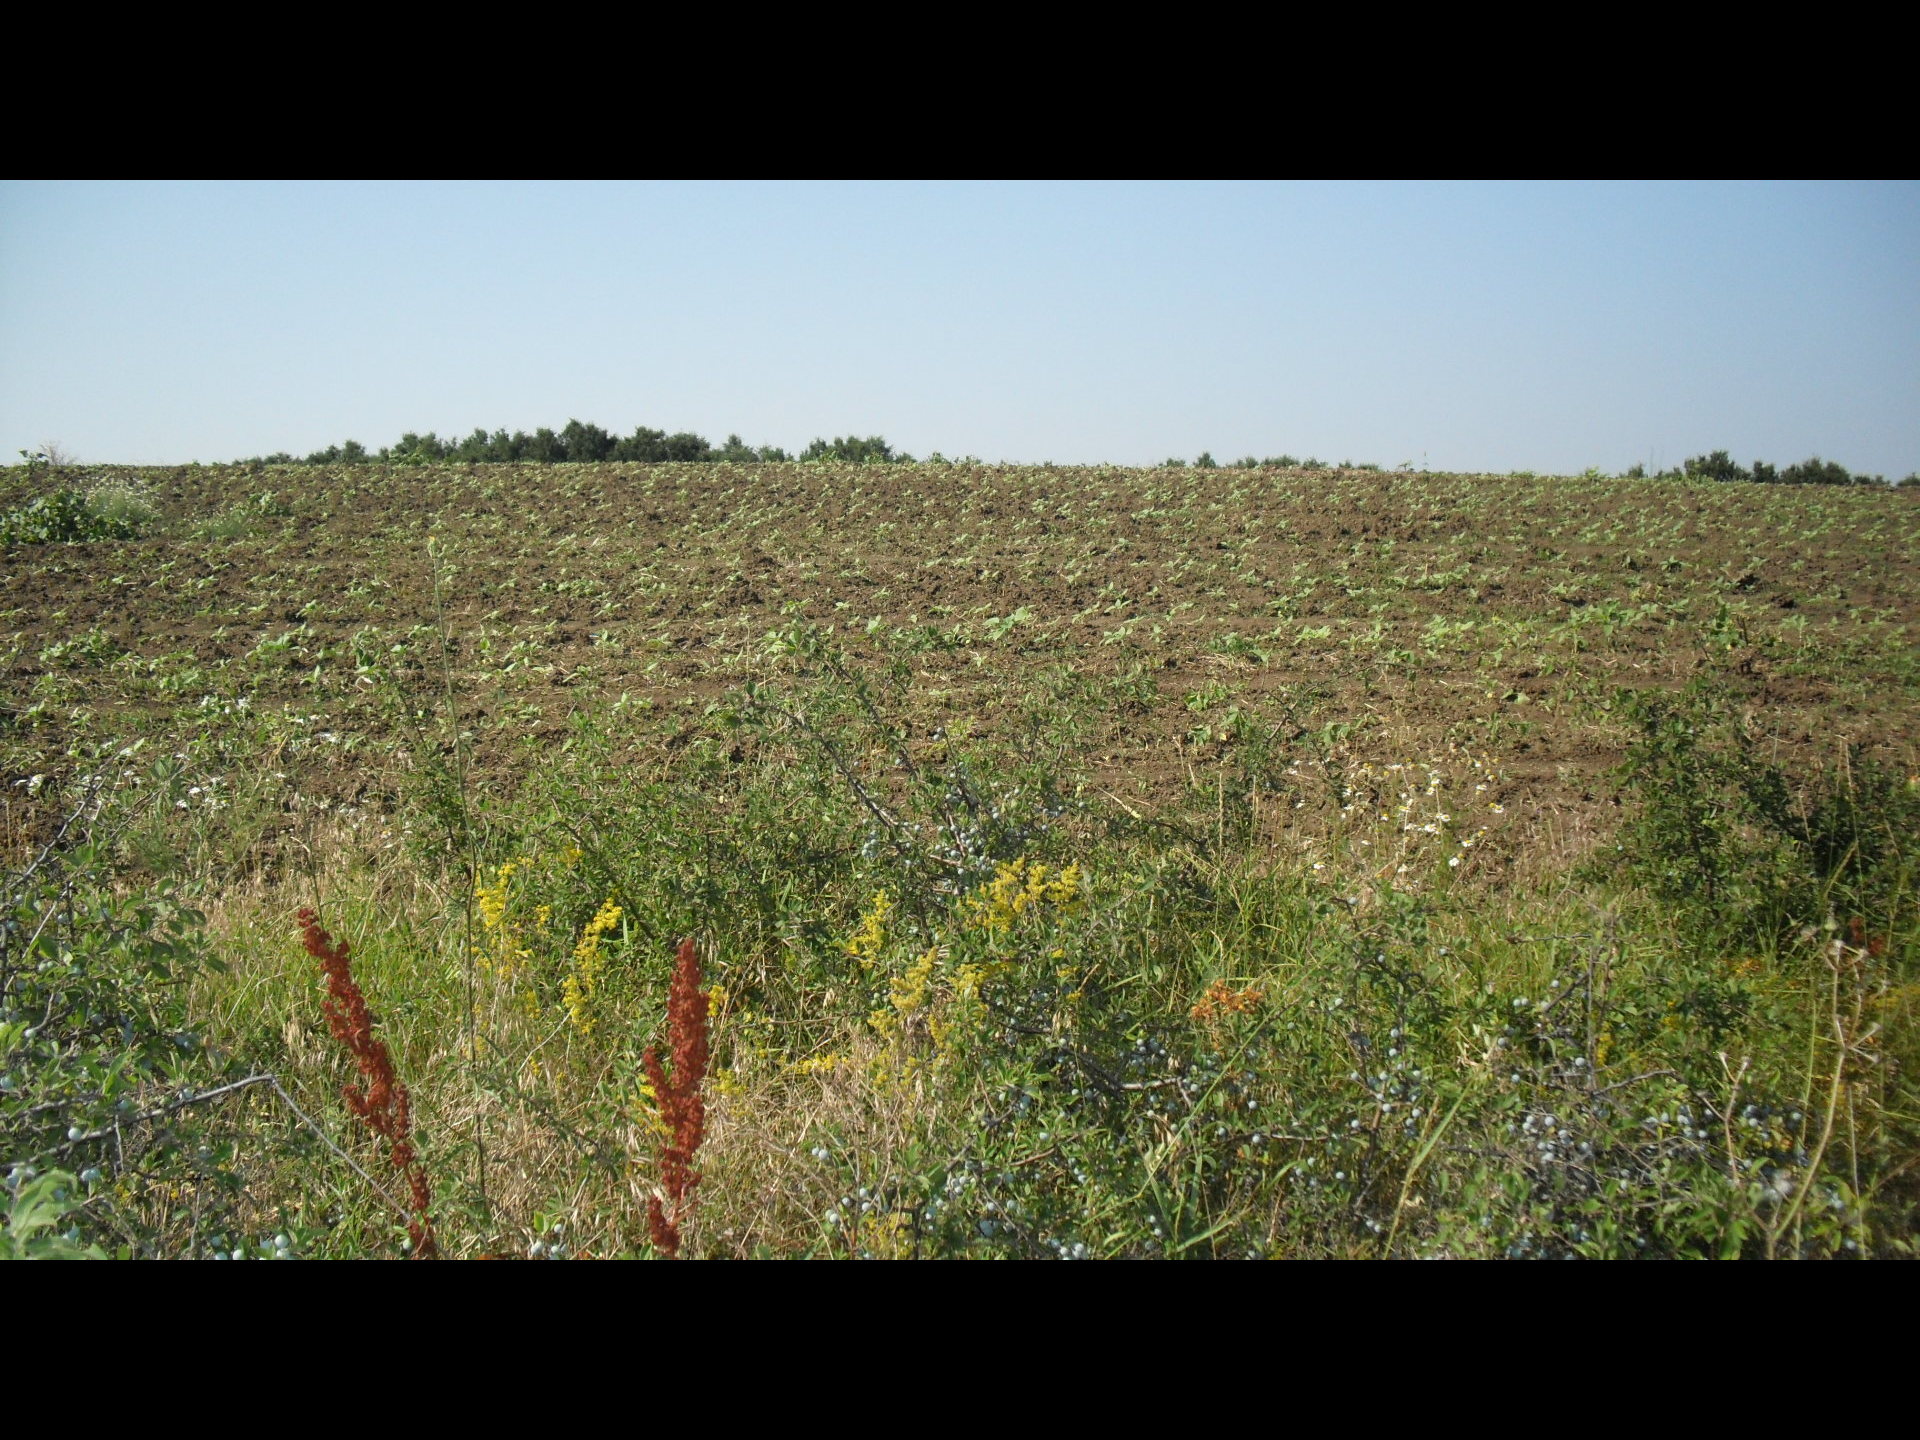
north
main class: Woodland
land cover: Broadleaved woodland
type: mesophytic deciduous forest
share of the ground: > 75 %
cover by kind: broadleaved forest trees 95 %, shrubs 5 %
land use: Forestry
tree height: > 5 m
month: July
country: BG
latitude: 43.7027
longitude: 22.7799
